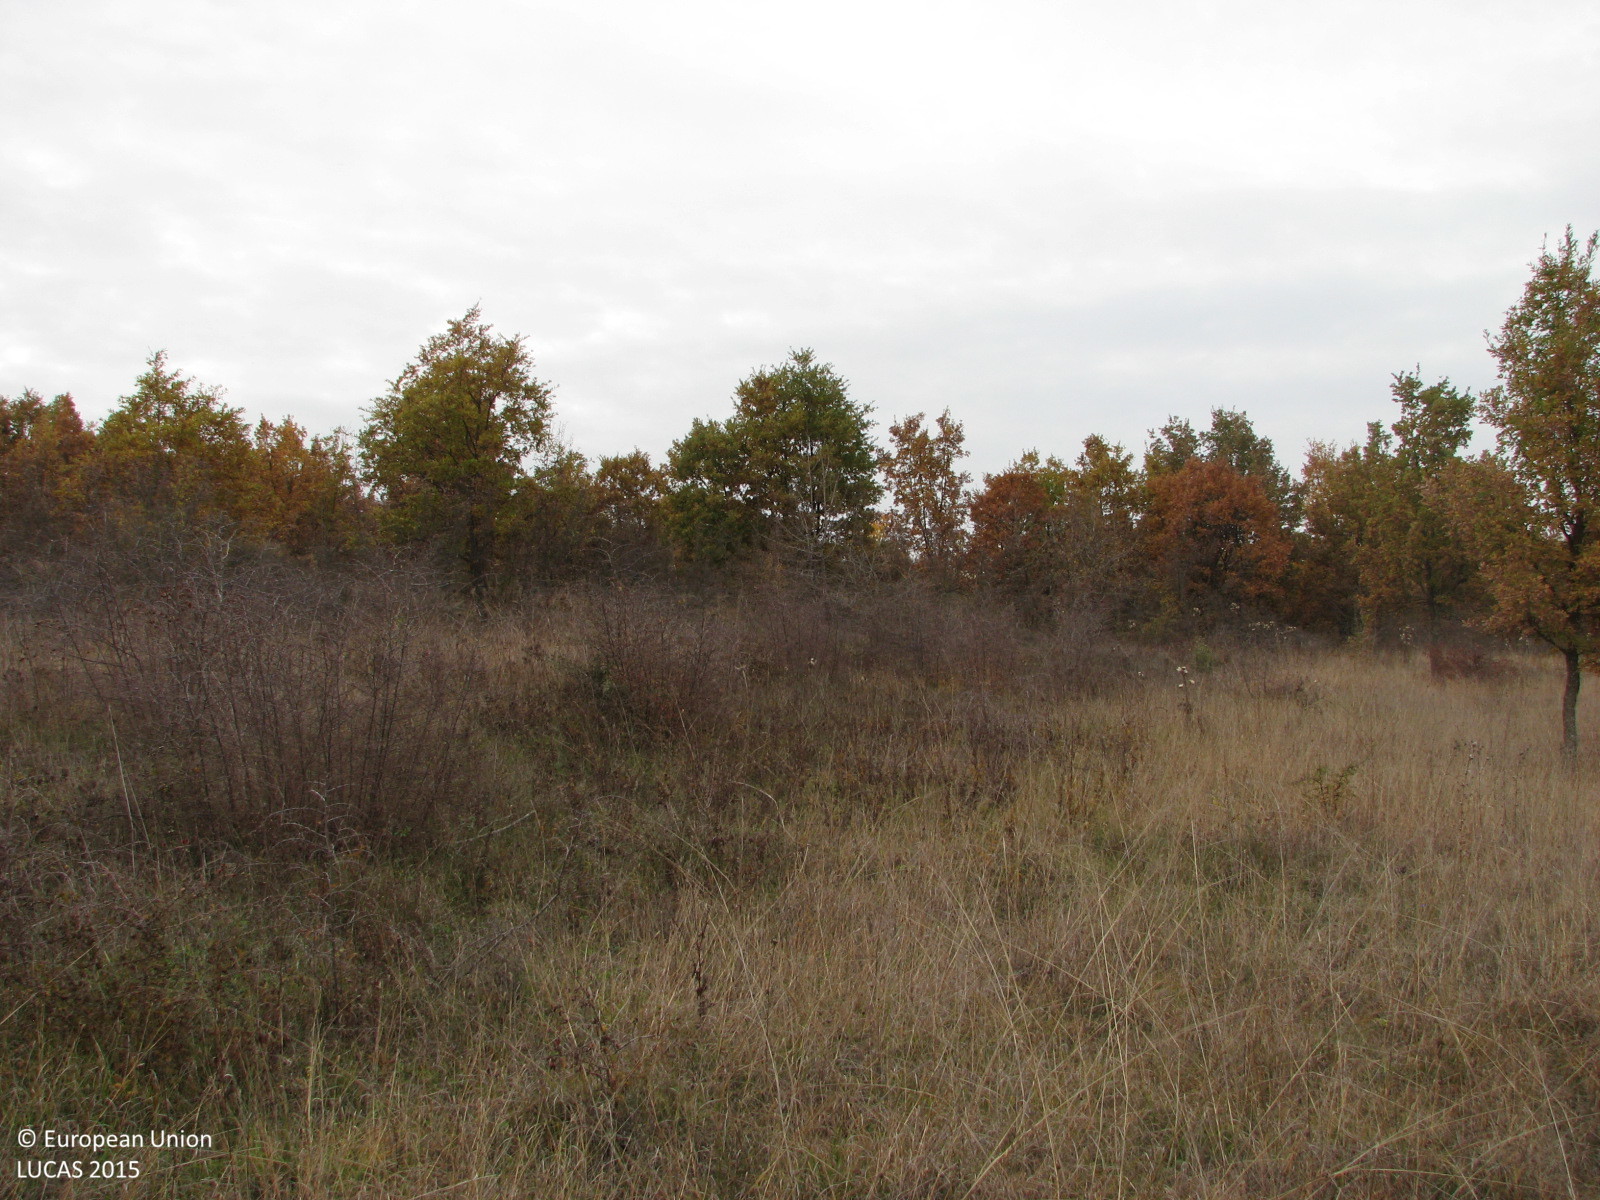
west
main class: Grassland
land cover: Grassland with sparse tree/shrub cover
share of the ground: > 75 %
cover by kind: herbaceous plants 90 %, broadleaved forest trees 5 %, shrubs 5 %
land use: Agriculture (excluding fallow land and kitchen gardens)
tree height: < 5 m
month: November
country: BG
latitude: 42.0551
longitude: 26.4335
